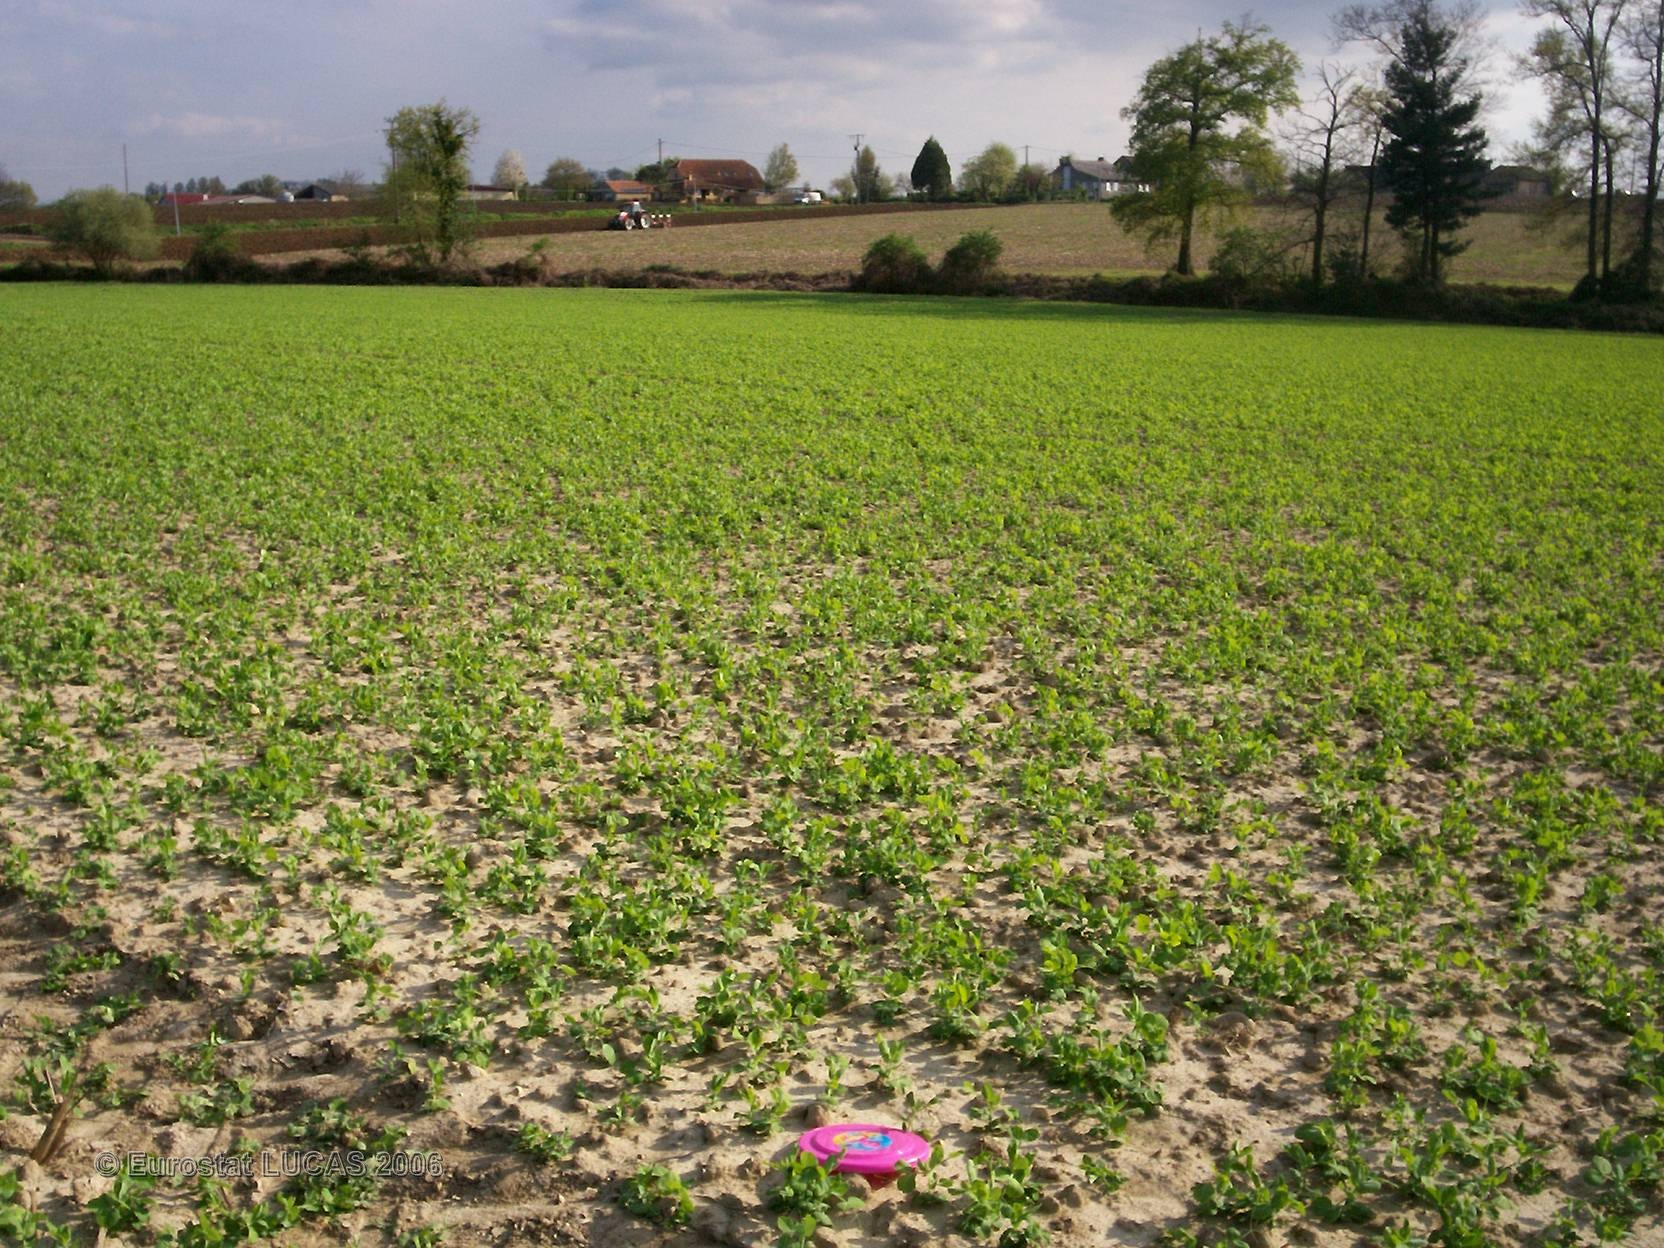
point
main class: Cropland
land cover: Dry pulses
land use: Agriculture (excluding fallow land and kitchen gardens)
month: April
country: FR
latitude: 43.4167
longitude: -0.3199
